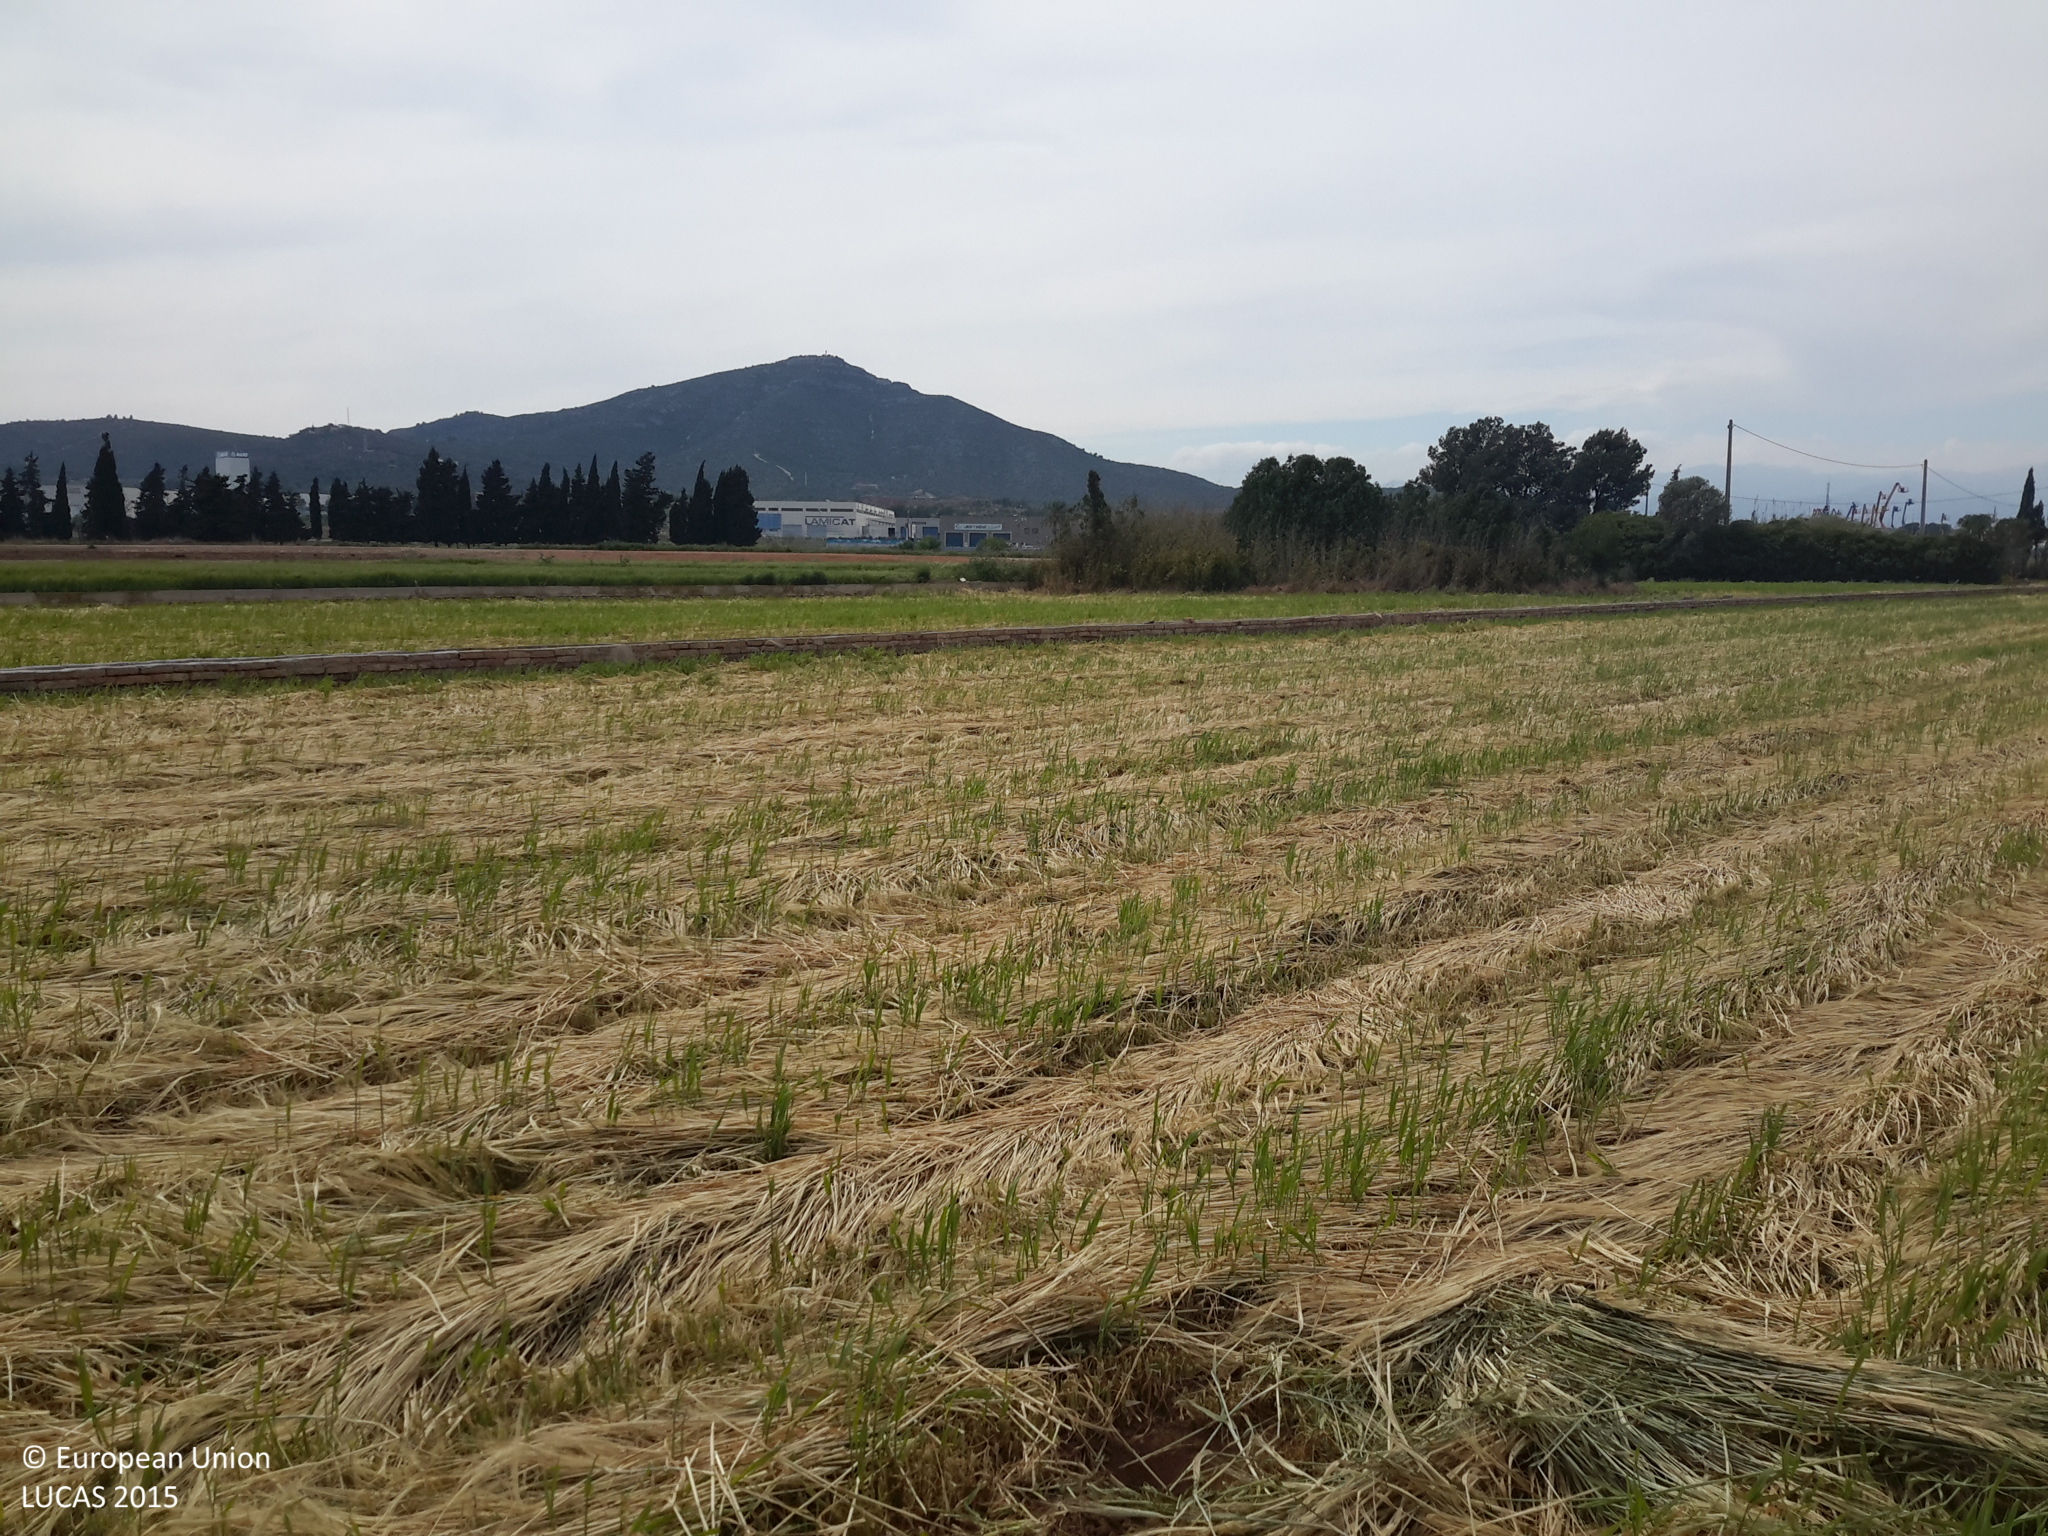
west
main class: Cropland
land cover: Common wheat
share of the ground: > 75 %
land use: Agriculture (excluding fallow land and kitchen gardens)
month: April
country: ES
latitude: 40.6876
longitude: 0.5881
